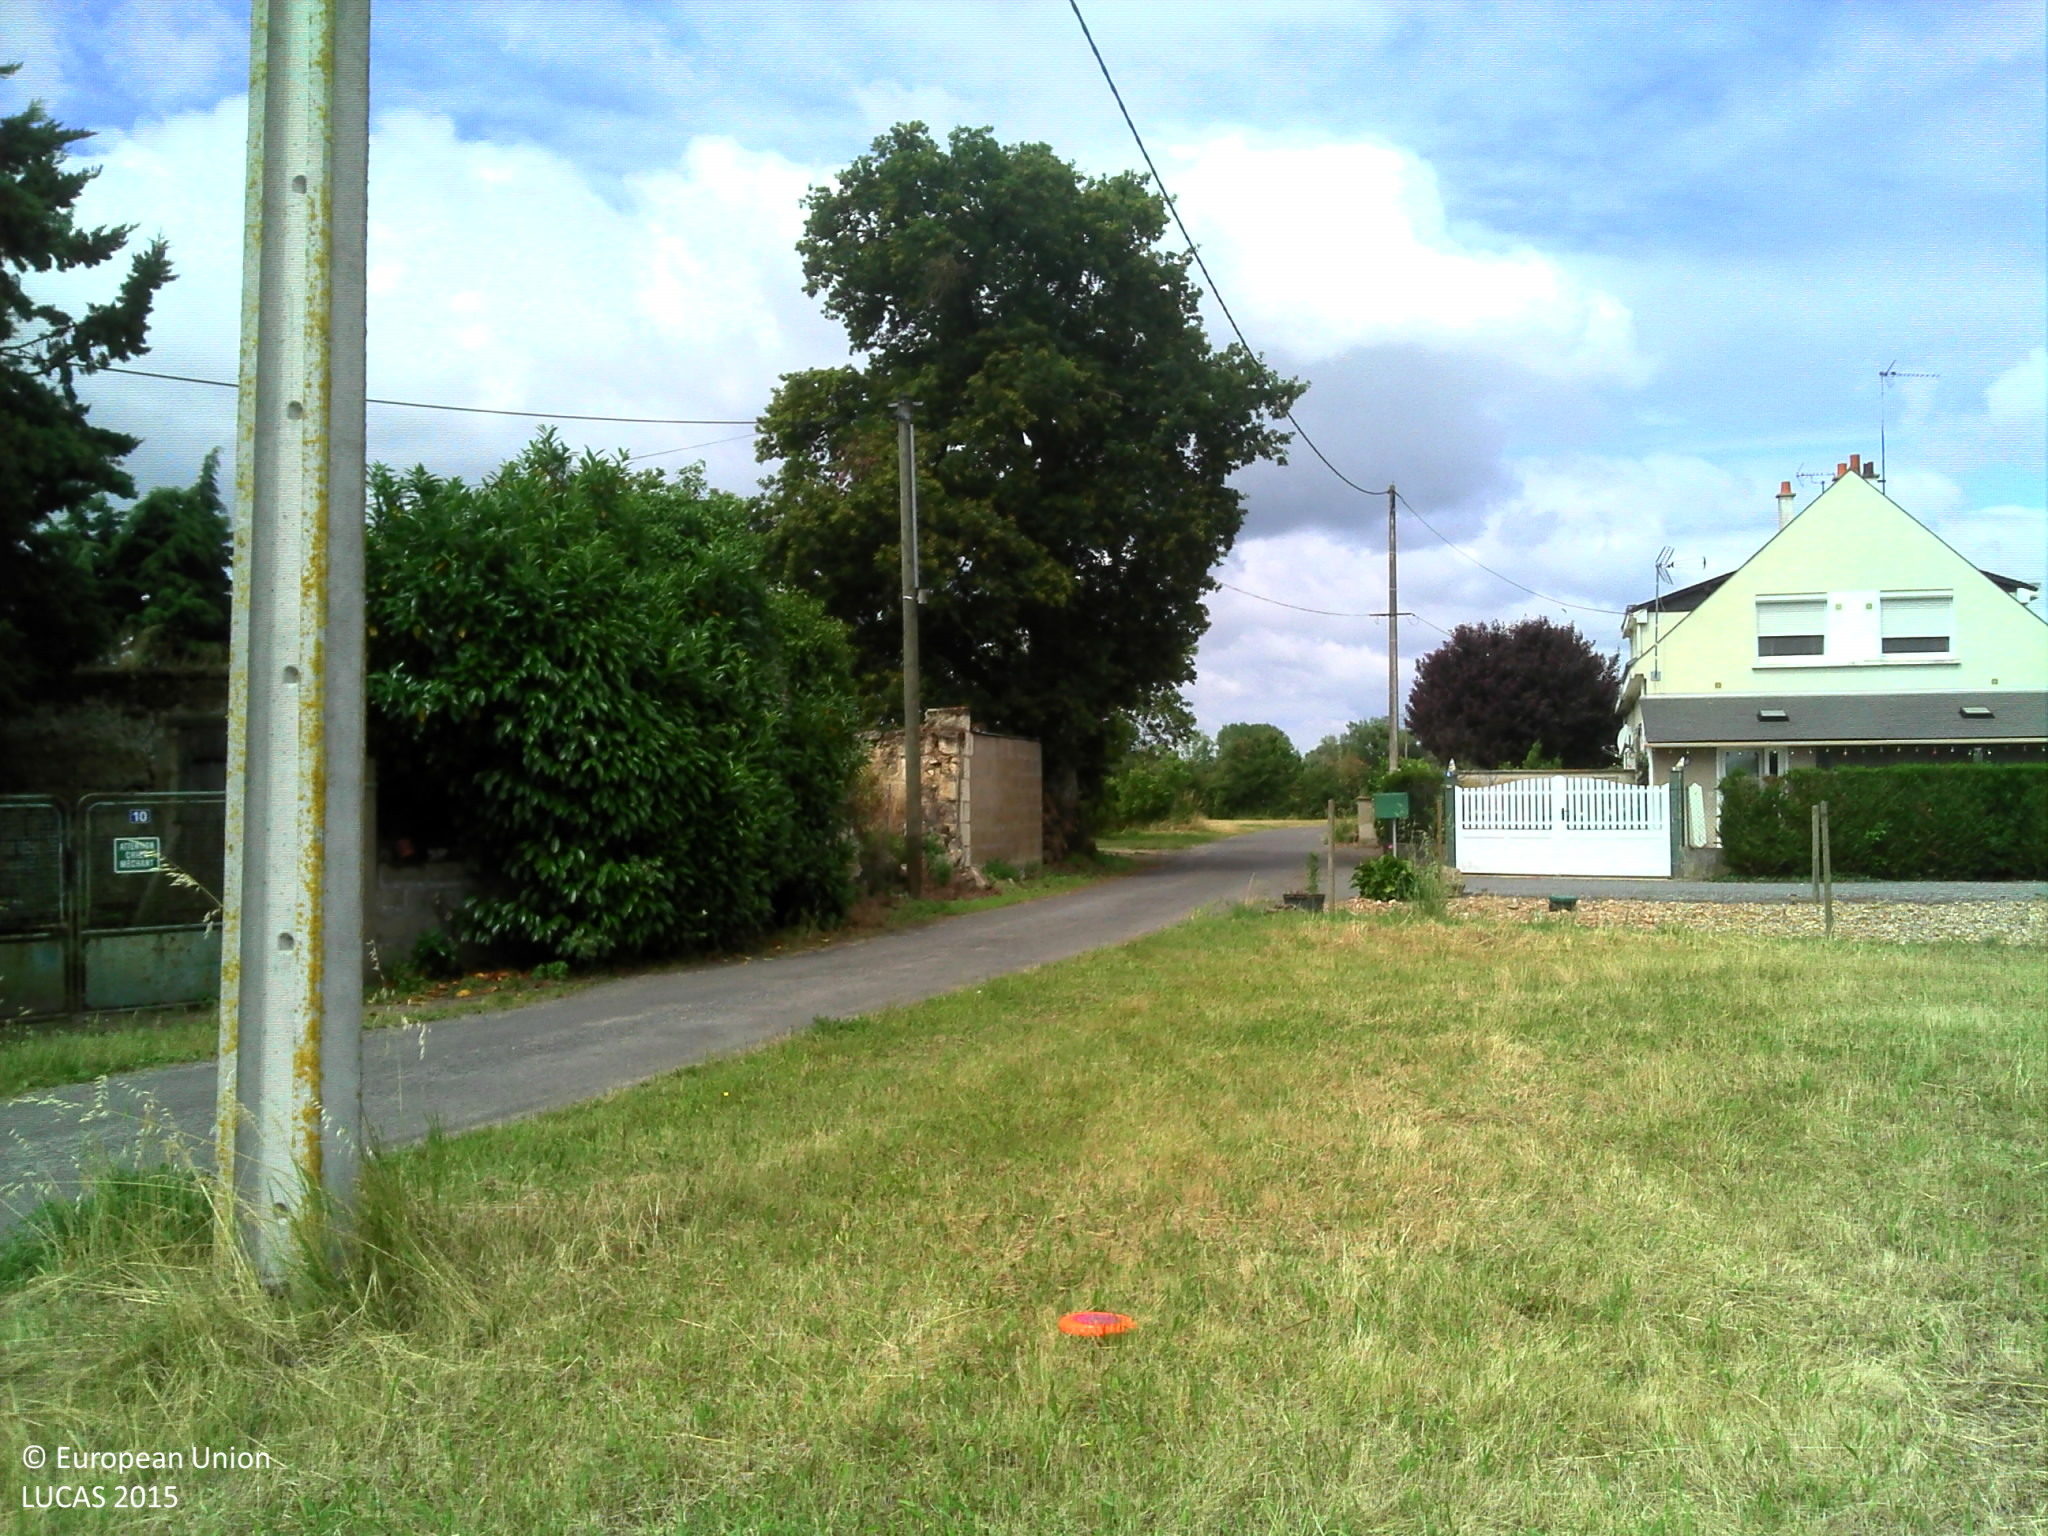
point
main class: Grassland
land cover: Grassland without tree/shrub cover
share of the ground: > 75 %
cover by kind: herbaceous plants 100 %
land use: Agriculture (excluding fallow land and kitchen gardens)
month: June
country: FR
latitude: 47.2290
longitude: 0.0568
